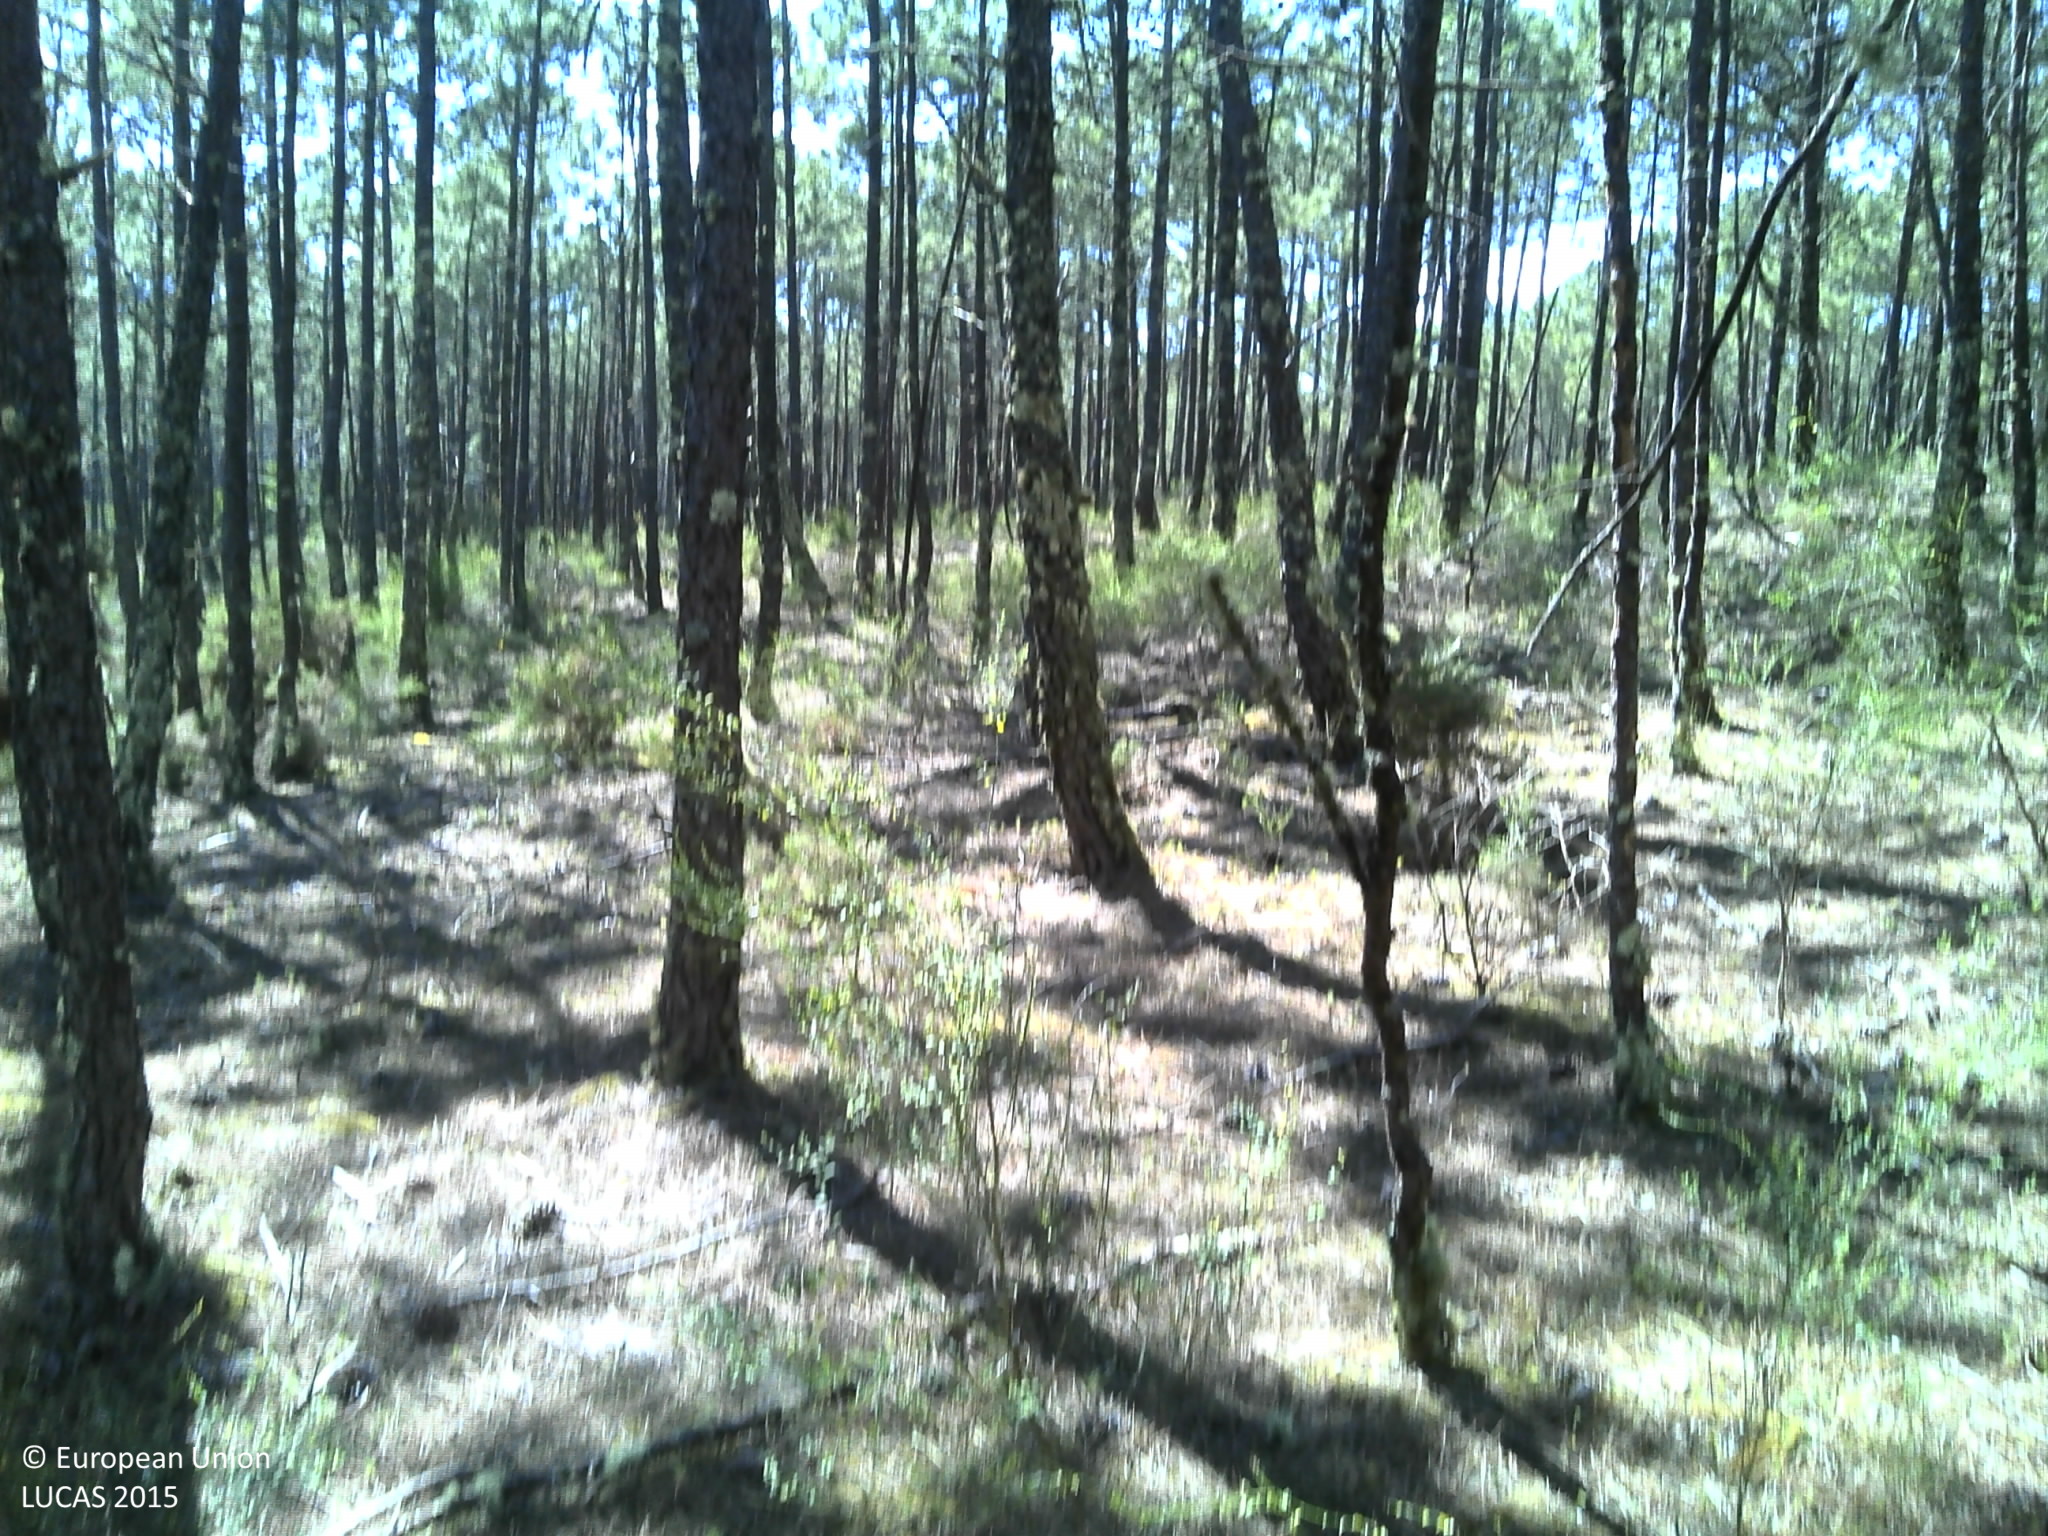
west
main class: Woodland
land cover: Pine dominated coniferous woodland
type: coniferous forest of the mediterranean region
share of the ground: 50 - 75 %
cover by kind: coniferous forest trees 75 %, unconsolidated bare surface 15 %, shrubs 10 %
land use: Forestry
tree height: > 5 m
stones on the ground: < 10 %
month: May
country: PT
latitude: 40.5742
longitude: -8.7274
